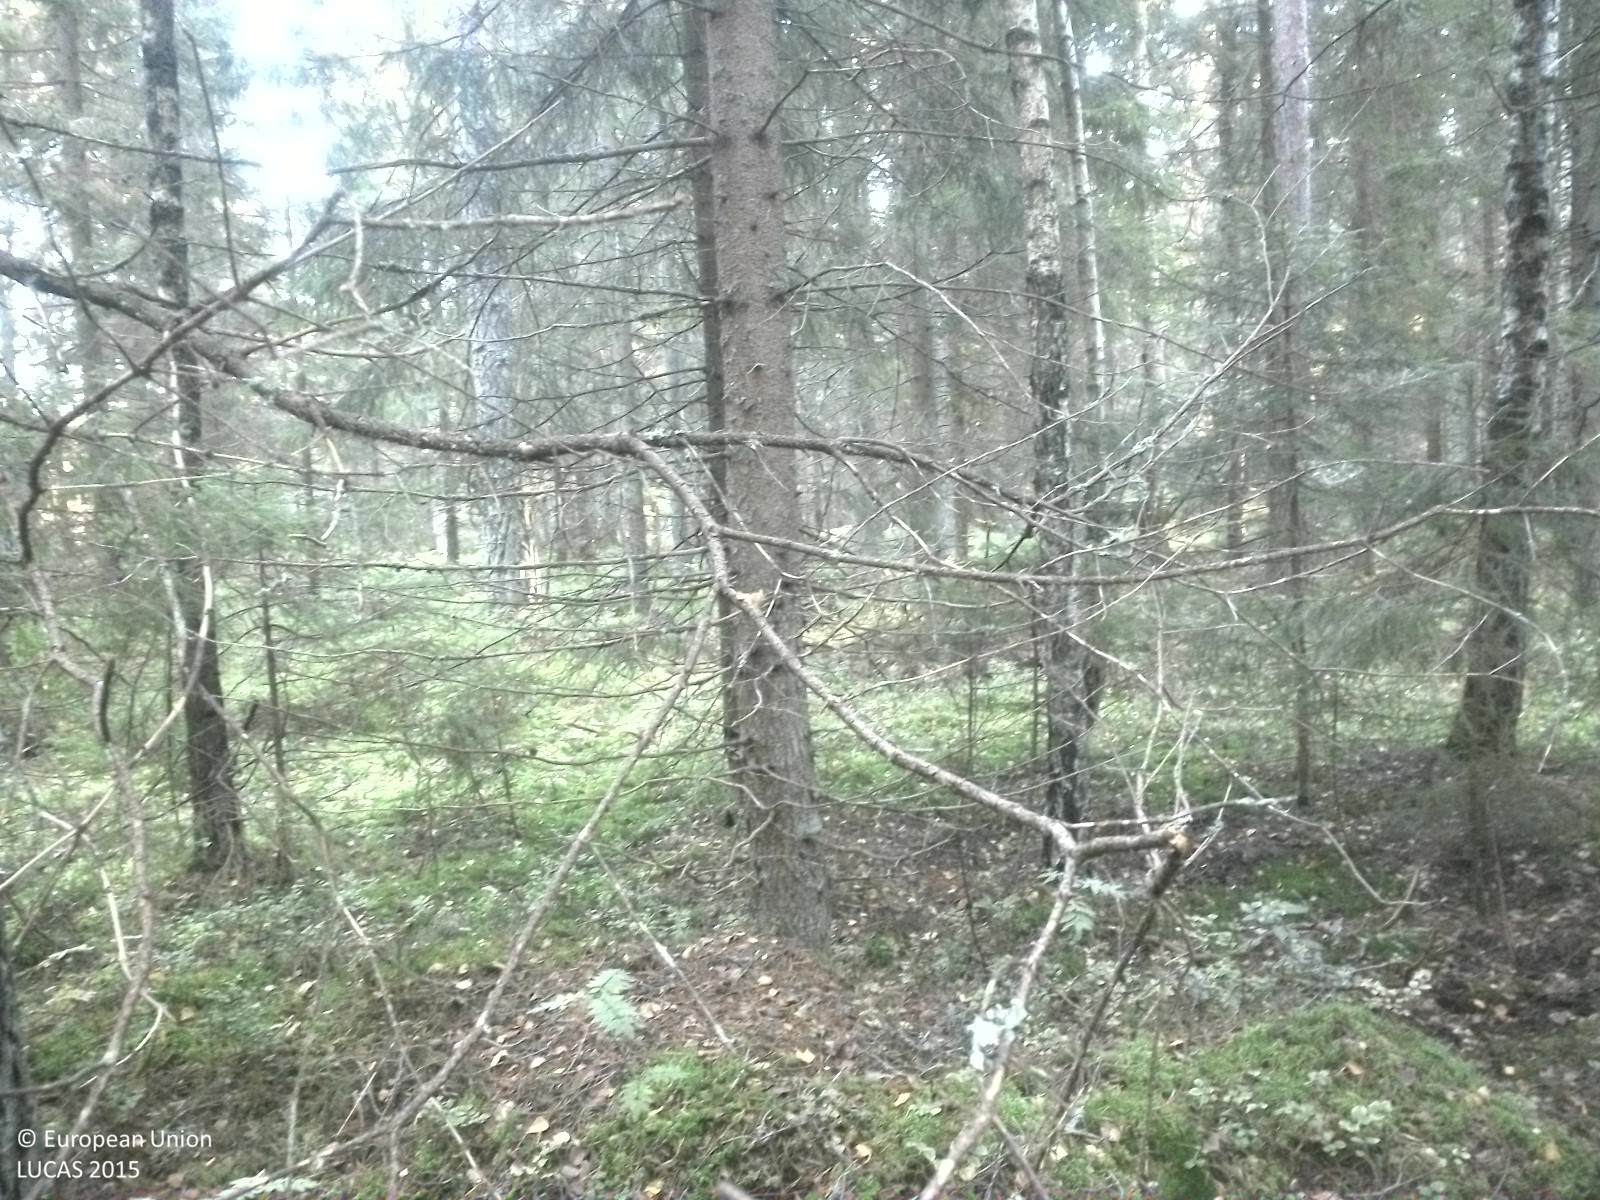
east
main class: Woodland
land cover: Spruce dominated mixed woodland
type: boreal forest
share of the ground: 50 - 75 %
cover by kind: coniferous forest trees 35 %, herbaceous plants 25 %, broadleaved forest trees 20 %, lichens and mosses 20 %
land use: Forestry
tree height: > 5 m
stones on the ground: < 10 %
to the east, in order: Spruce dominated mixed woodland; Spruce dominated coniferous woodland; Grassland with sparse tree/shrub cover; Grassland without tree/shrub cover; Ditches and canals; Grassland without tree/shrub cover
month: September
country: SE
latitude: 58.7183
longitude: 16.7472
